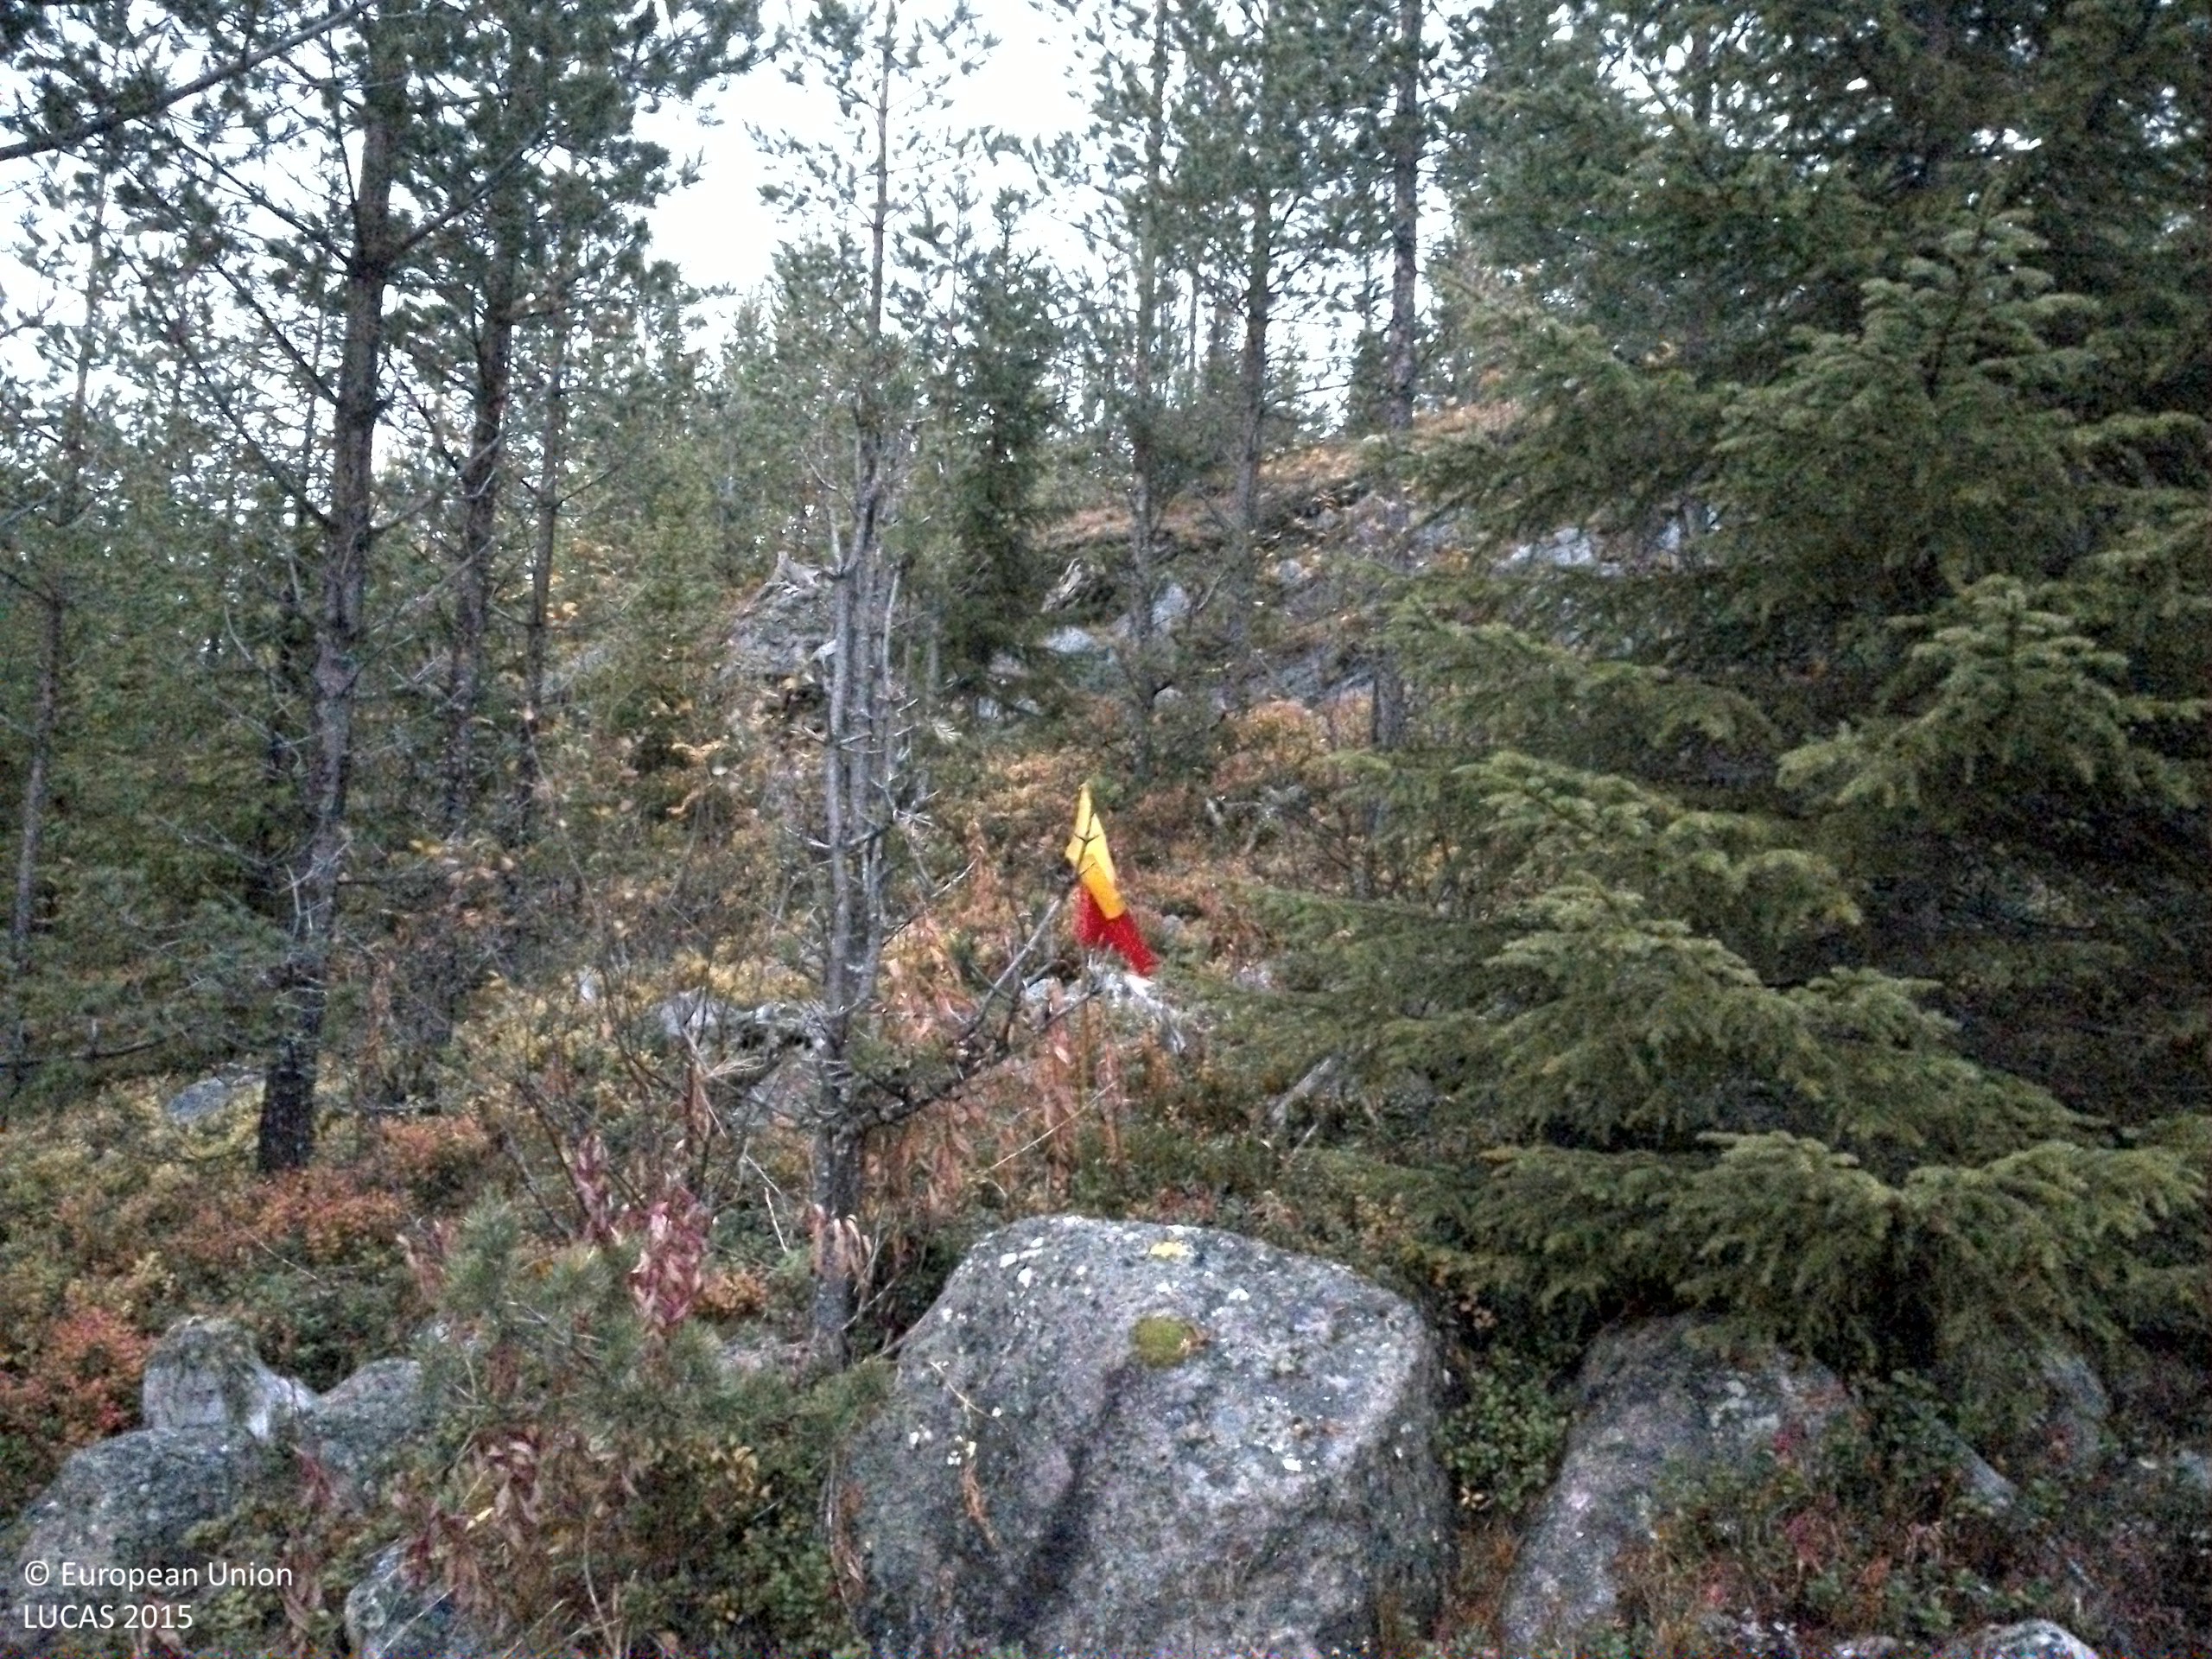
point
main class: Woodland
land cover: Pine dominated coniferous woodland
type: boreal forest
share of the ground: 25 - 50 %
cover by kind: coniferous forest trees 35 %, shrubs 25 %, consolidated bare surface 20 %, lichens and mosses 15 %, broadleaved forest trees 5 %
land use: Forestry
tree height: > 5 m
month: October
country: SE
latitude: 64.3308
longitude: 15.2066
